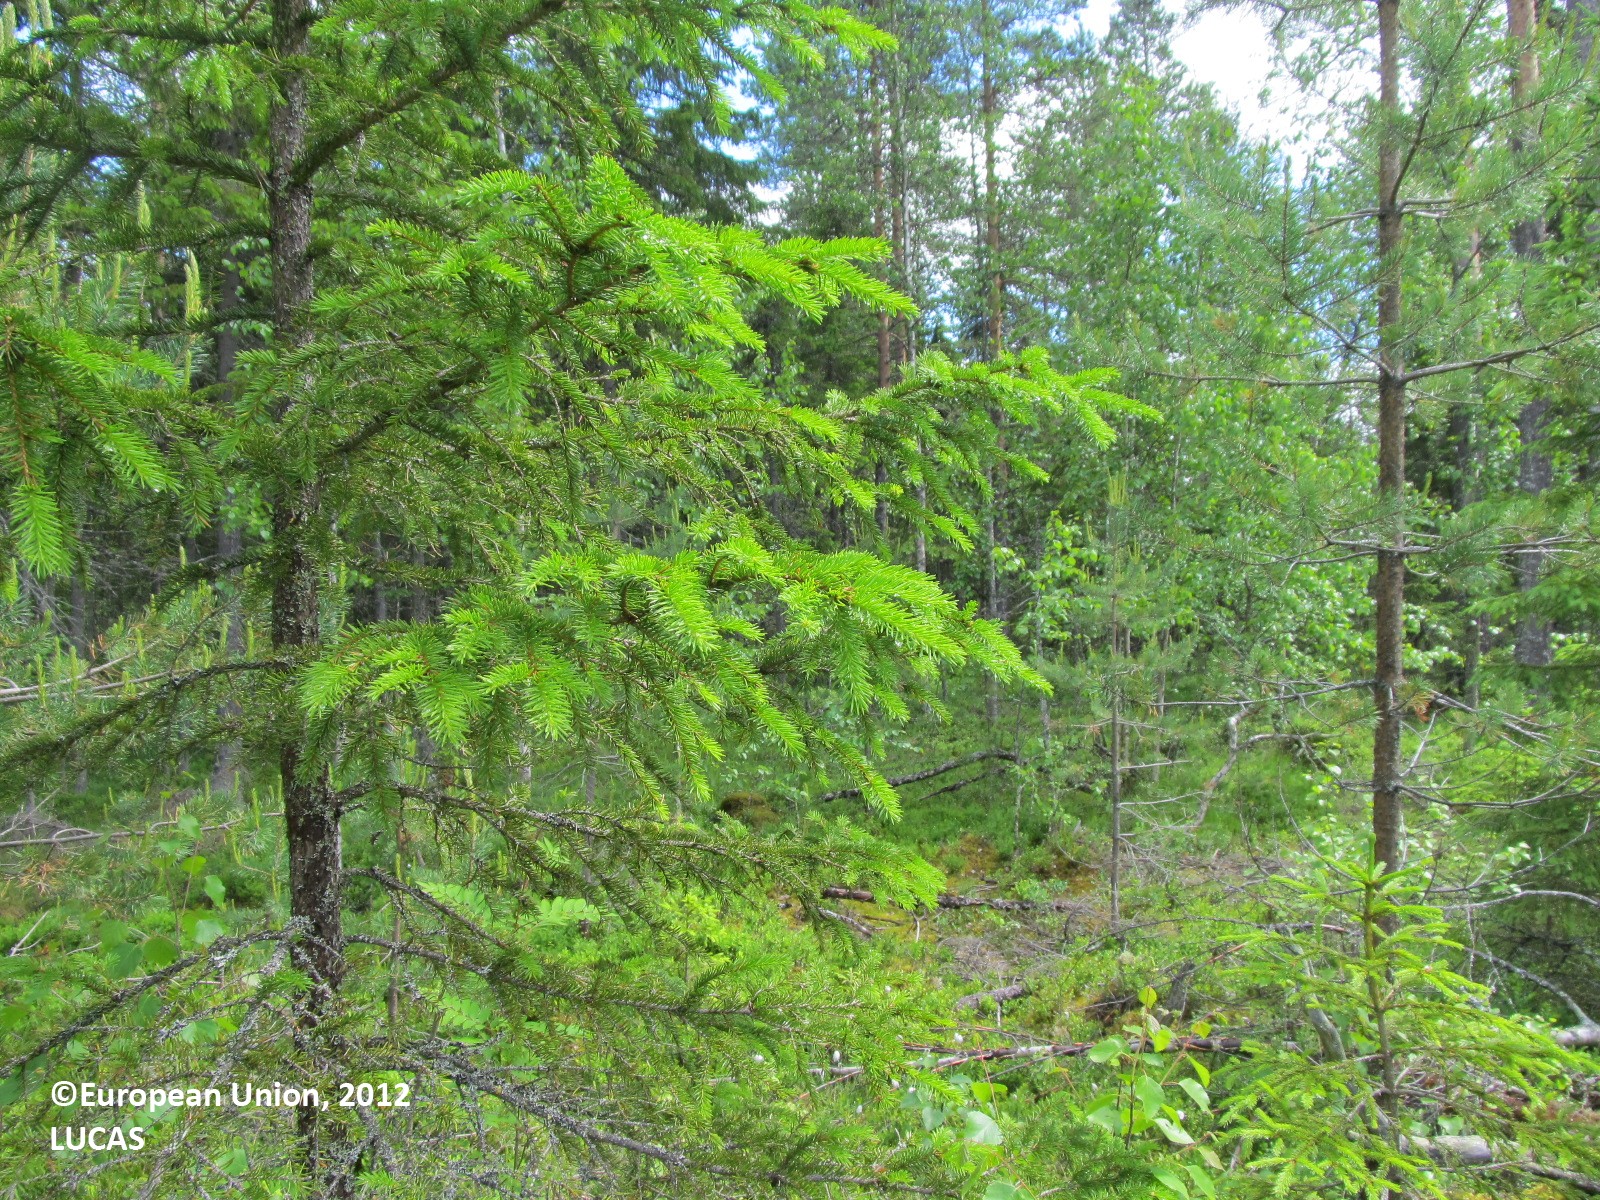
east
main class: Woodland
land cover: Spruce dominated mixed woodland
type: boreal forest
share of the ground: 50 - 75 %
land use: Forestry
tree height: < 5 m
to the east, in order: Spruce dominated mixed woodland; Spruce dominated coniferous woodland; Pine dominated coniferous woodland; Pine dominated mixed woodland; Paved roads, cycling and walking lanes; Spruce dominated mixed woodland
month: June
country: FI
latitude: 62.9956
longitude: 28.9458
